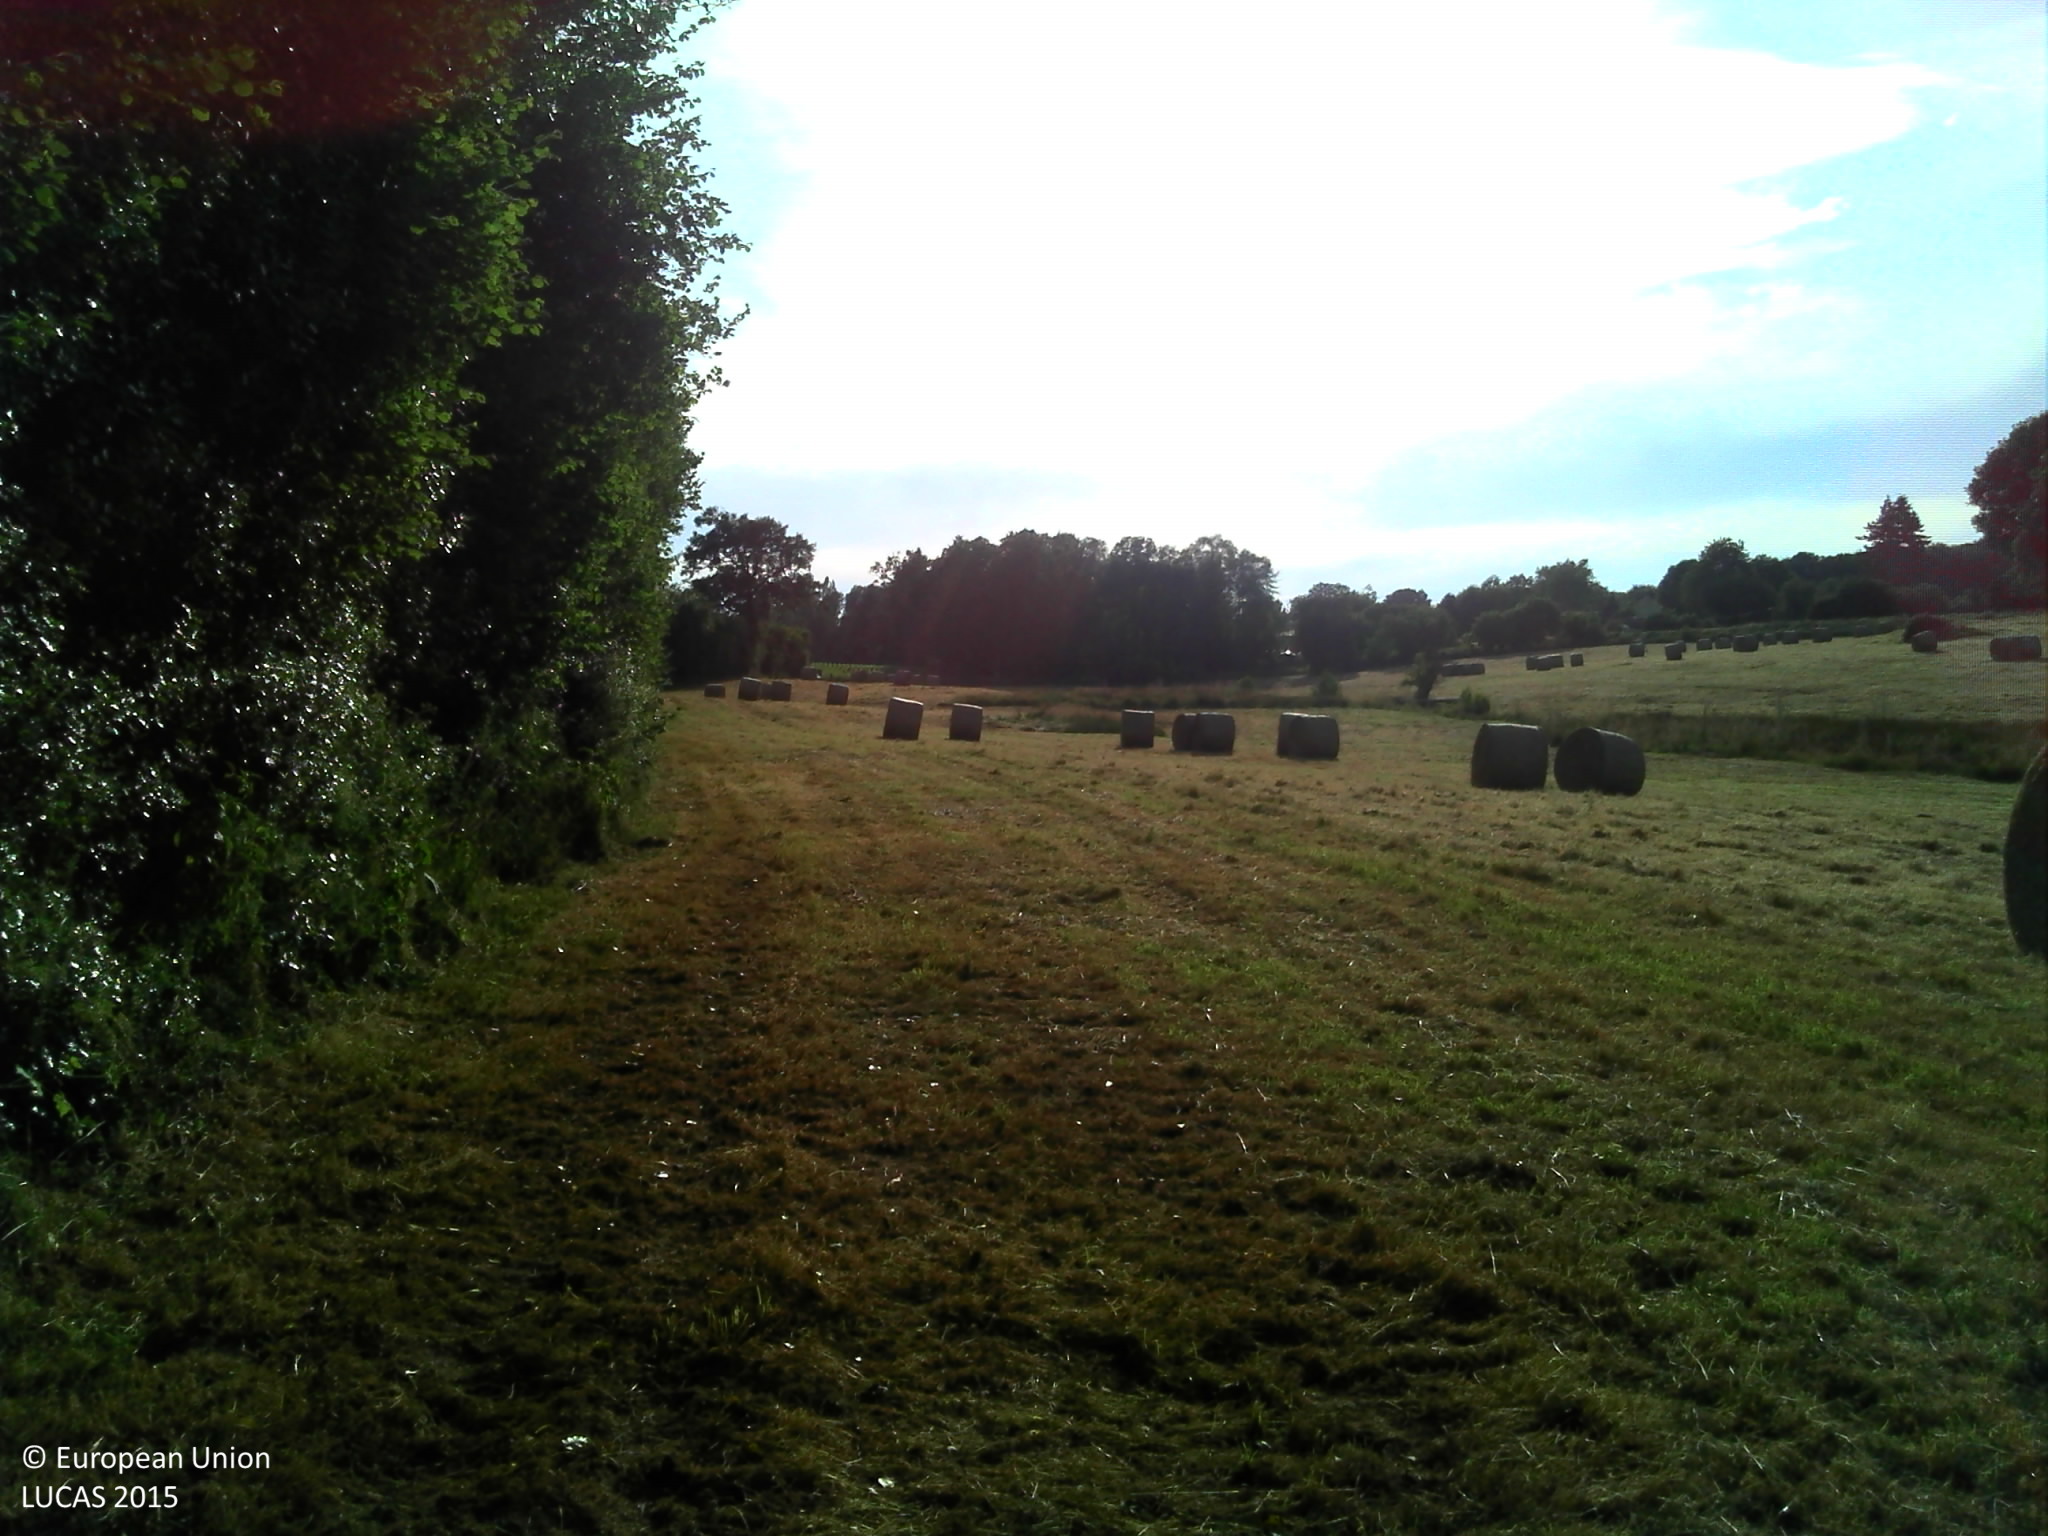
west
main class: Grassland
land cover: Grassland without tree/shrub cover
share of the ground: > 75 %
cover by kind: herbaceous plants 100 %
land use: Agriculture (excluding fallow land and kitchen gardens)
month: June
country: FR
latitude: 48.5823
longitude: -0.2123
